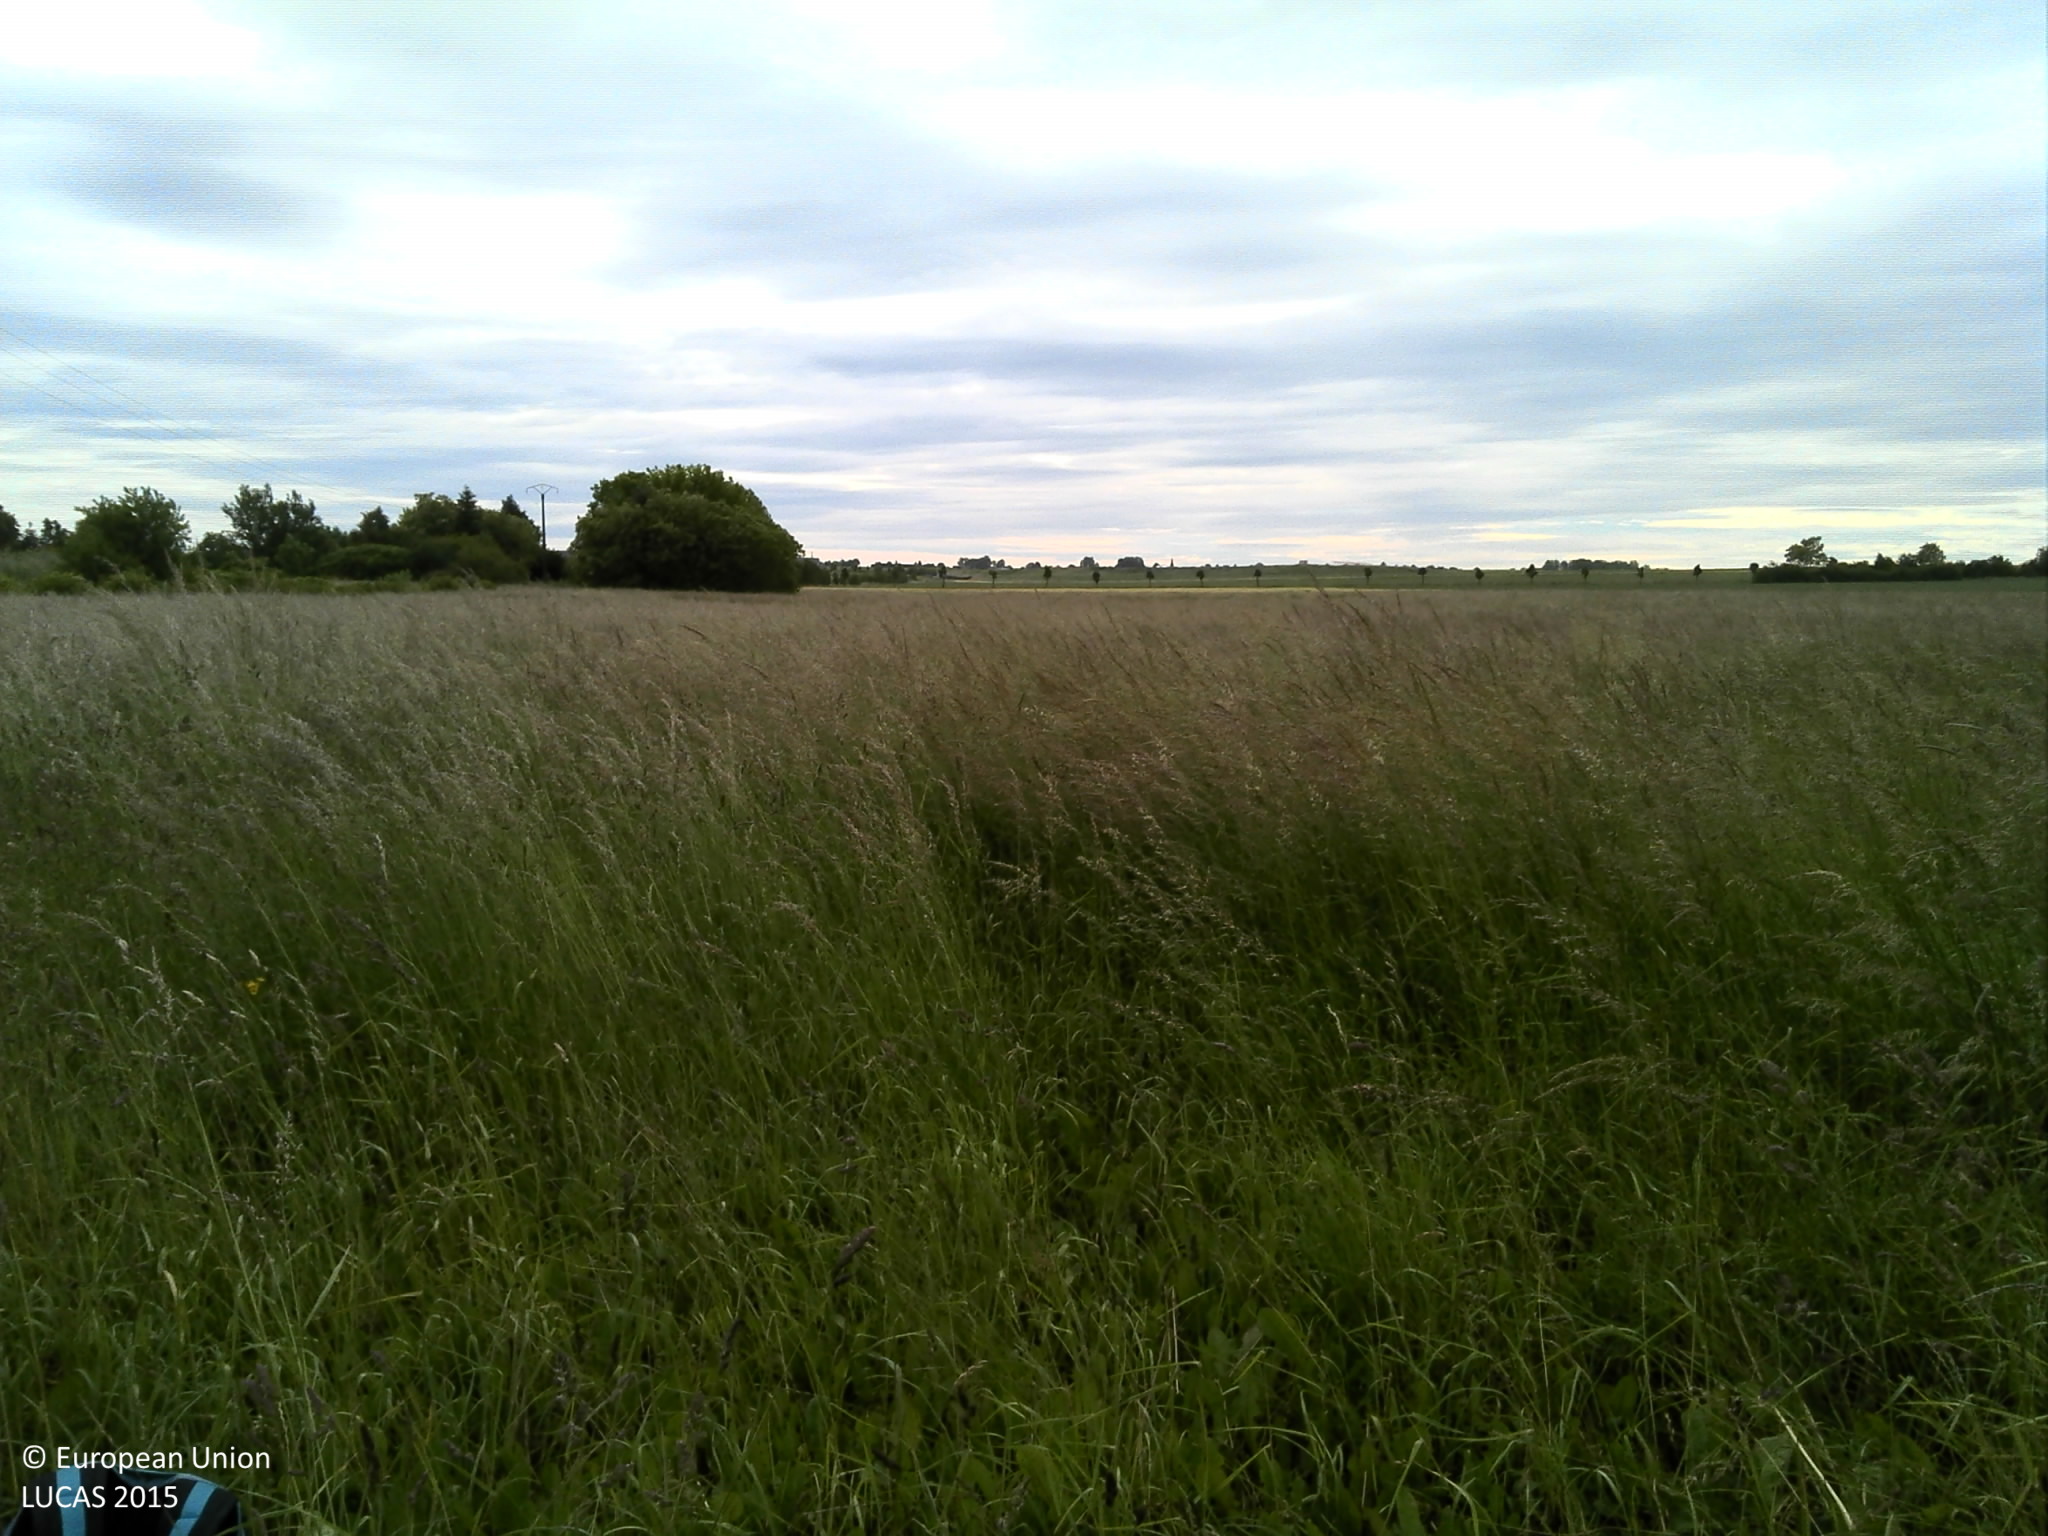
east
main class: Grassland
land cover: Grassland without tree/shrub cover
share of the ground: > 75 %
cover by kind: herbaceous plants 100 %
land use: Agriculture (excluding fallow land and kitchen gardens)
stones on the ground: < 10 %
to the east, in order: Grassland without tree/shrub cover
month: June
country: FR
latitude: 48.9691
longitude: 6.2159
